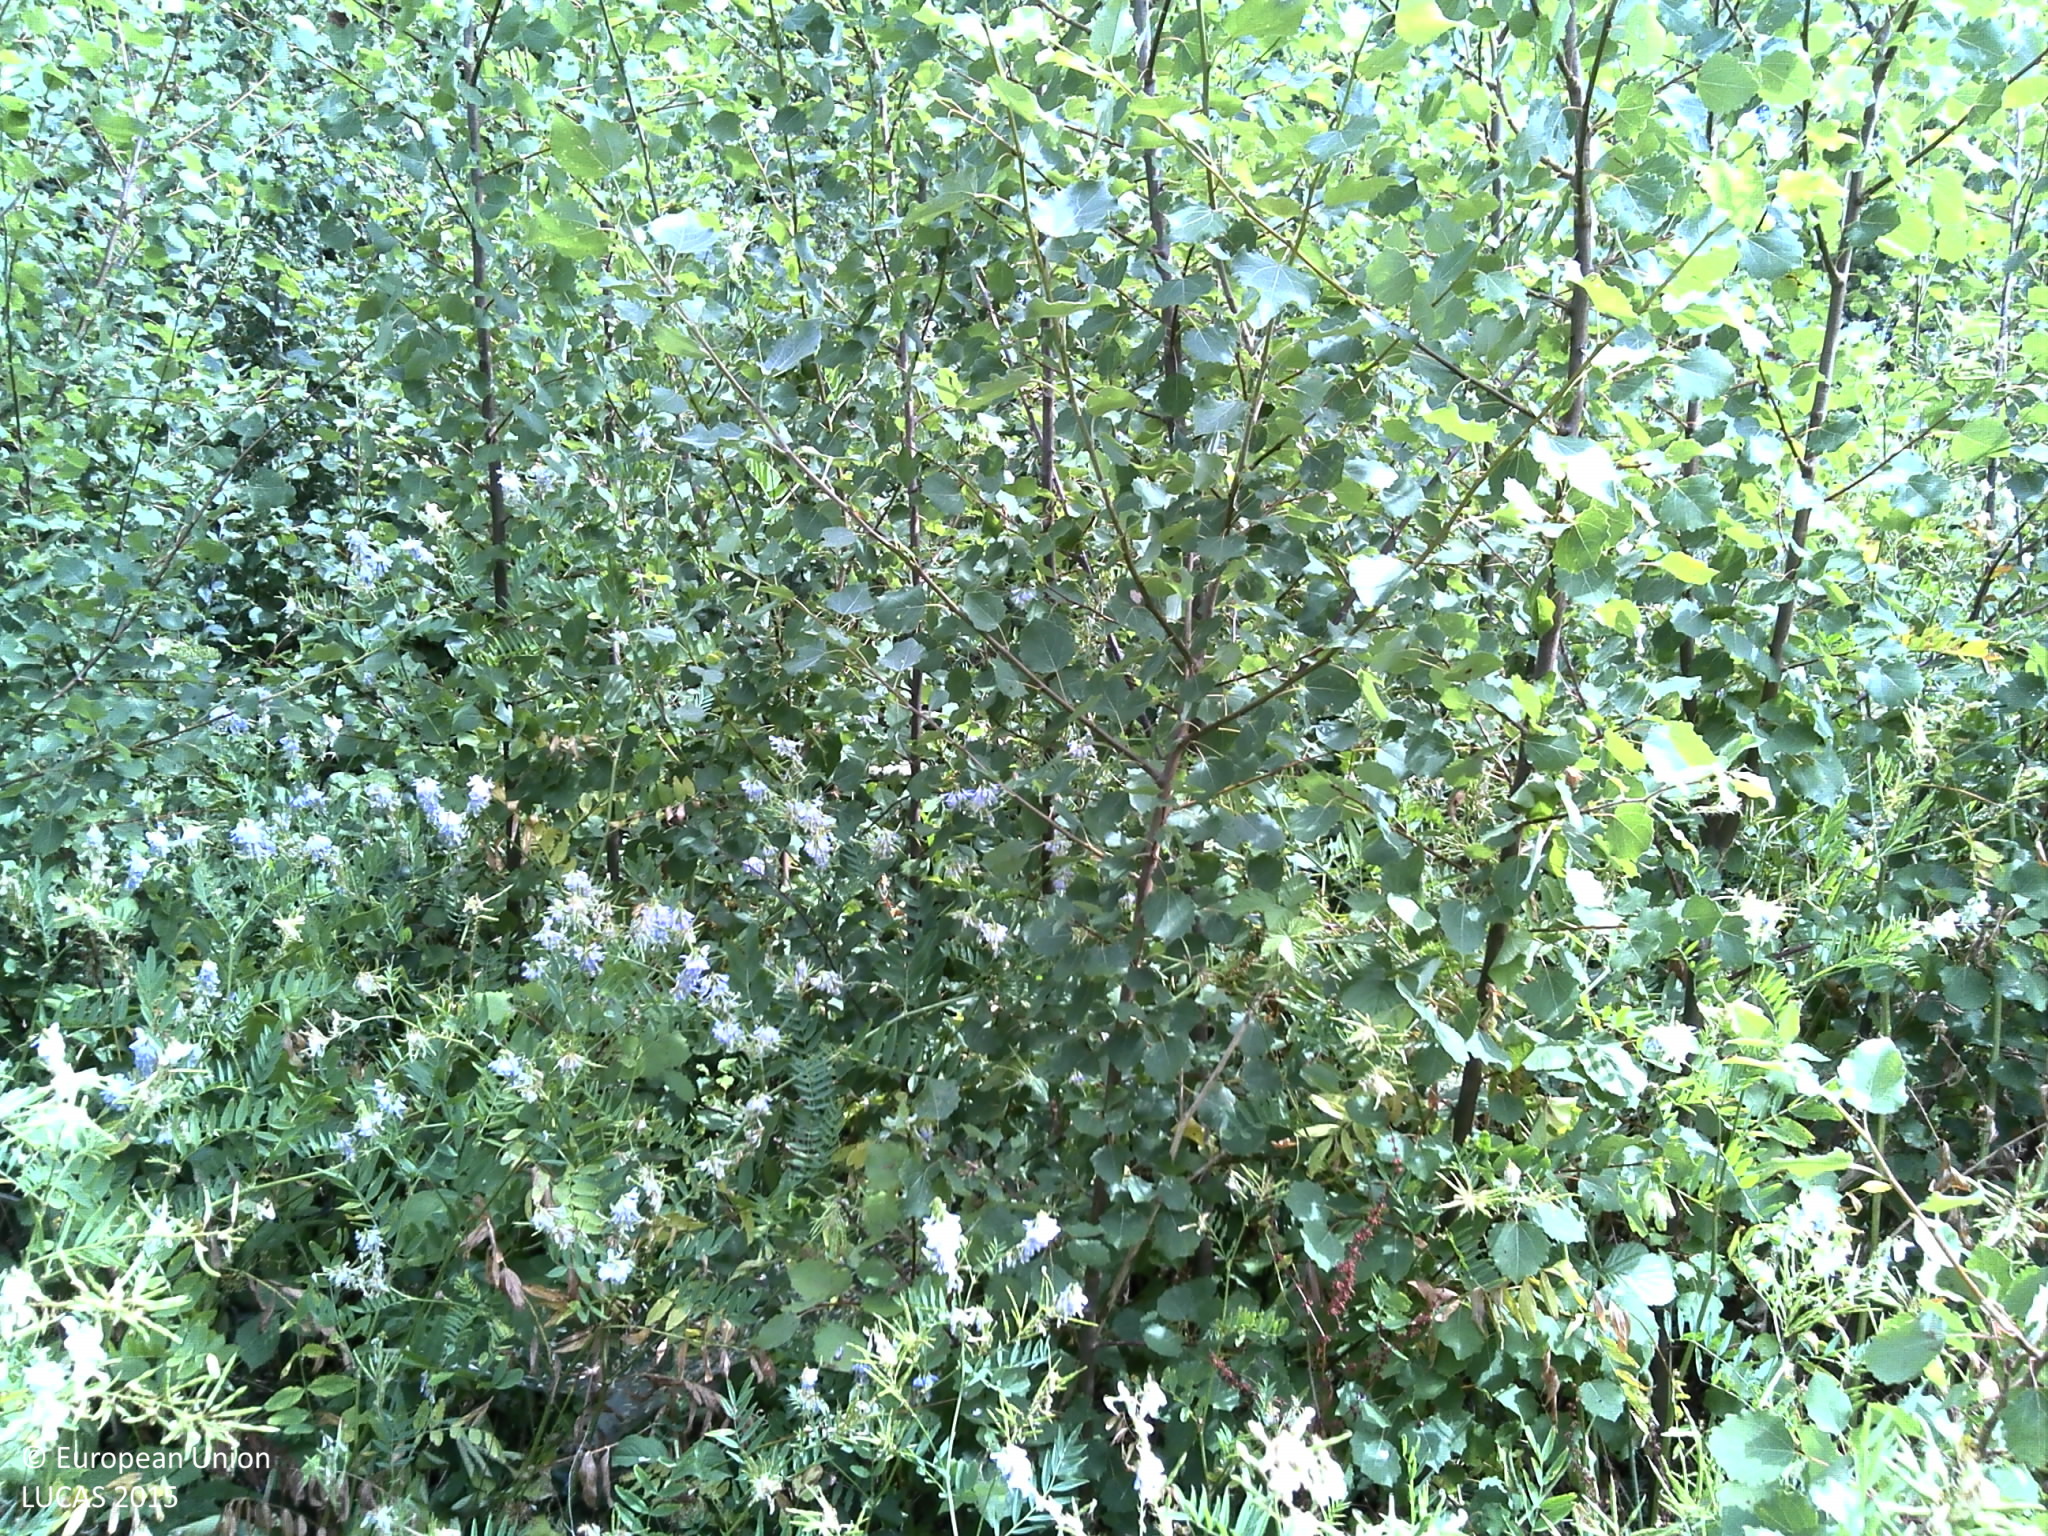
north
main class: Grassland
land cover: Spontaneously vegetated surfaces
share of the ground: > 75 %
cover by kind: herbaceous plants 95 %, shrubs 5 %
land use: Semi-natural and natural areas not in use
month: July
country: FR
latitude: 48.8992
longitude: 4.9096
